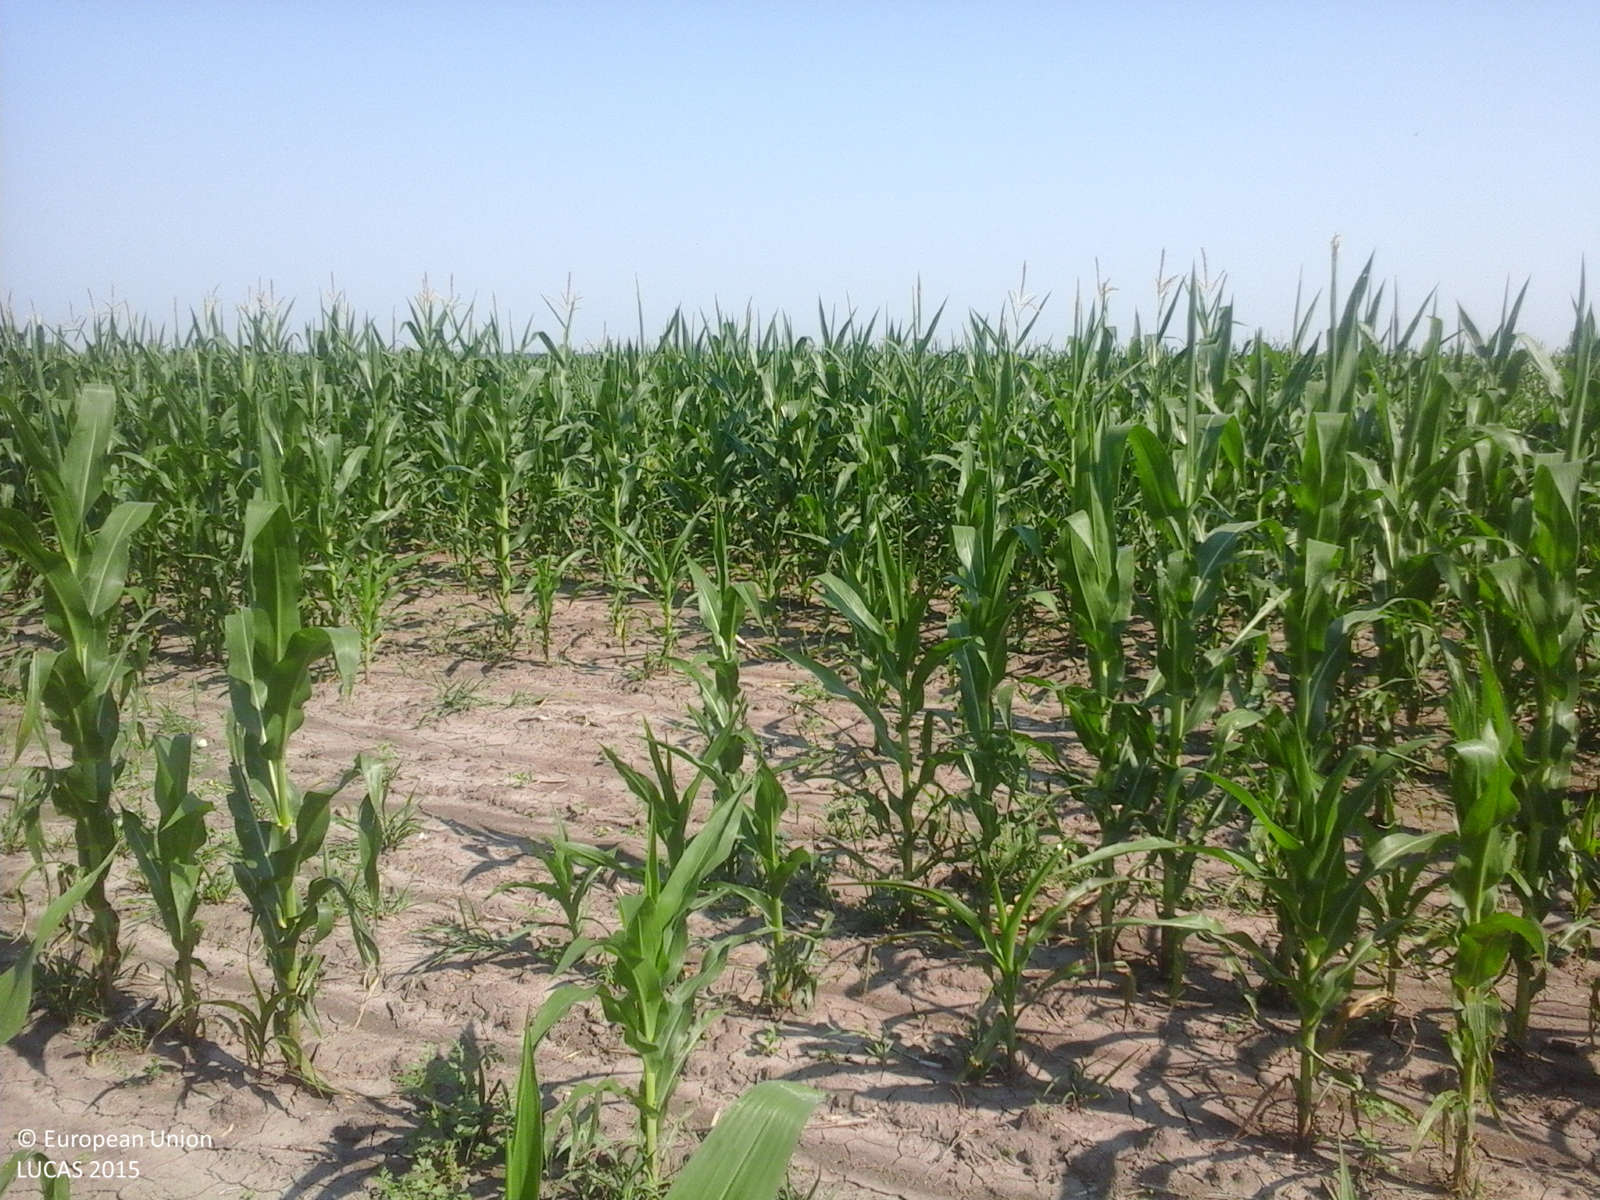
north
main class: Cropland
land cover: Maize
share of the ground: > 75 %
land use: Agriculture (excluding fallow land and kitchen gardens)
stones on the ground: < 10 %
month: July
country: RO
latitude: 44.5046
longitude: 24.8316
